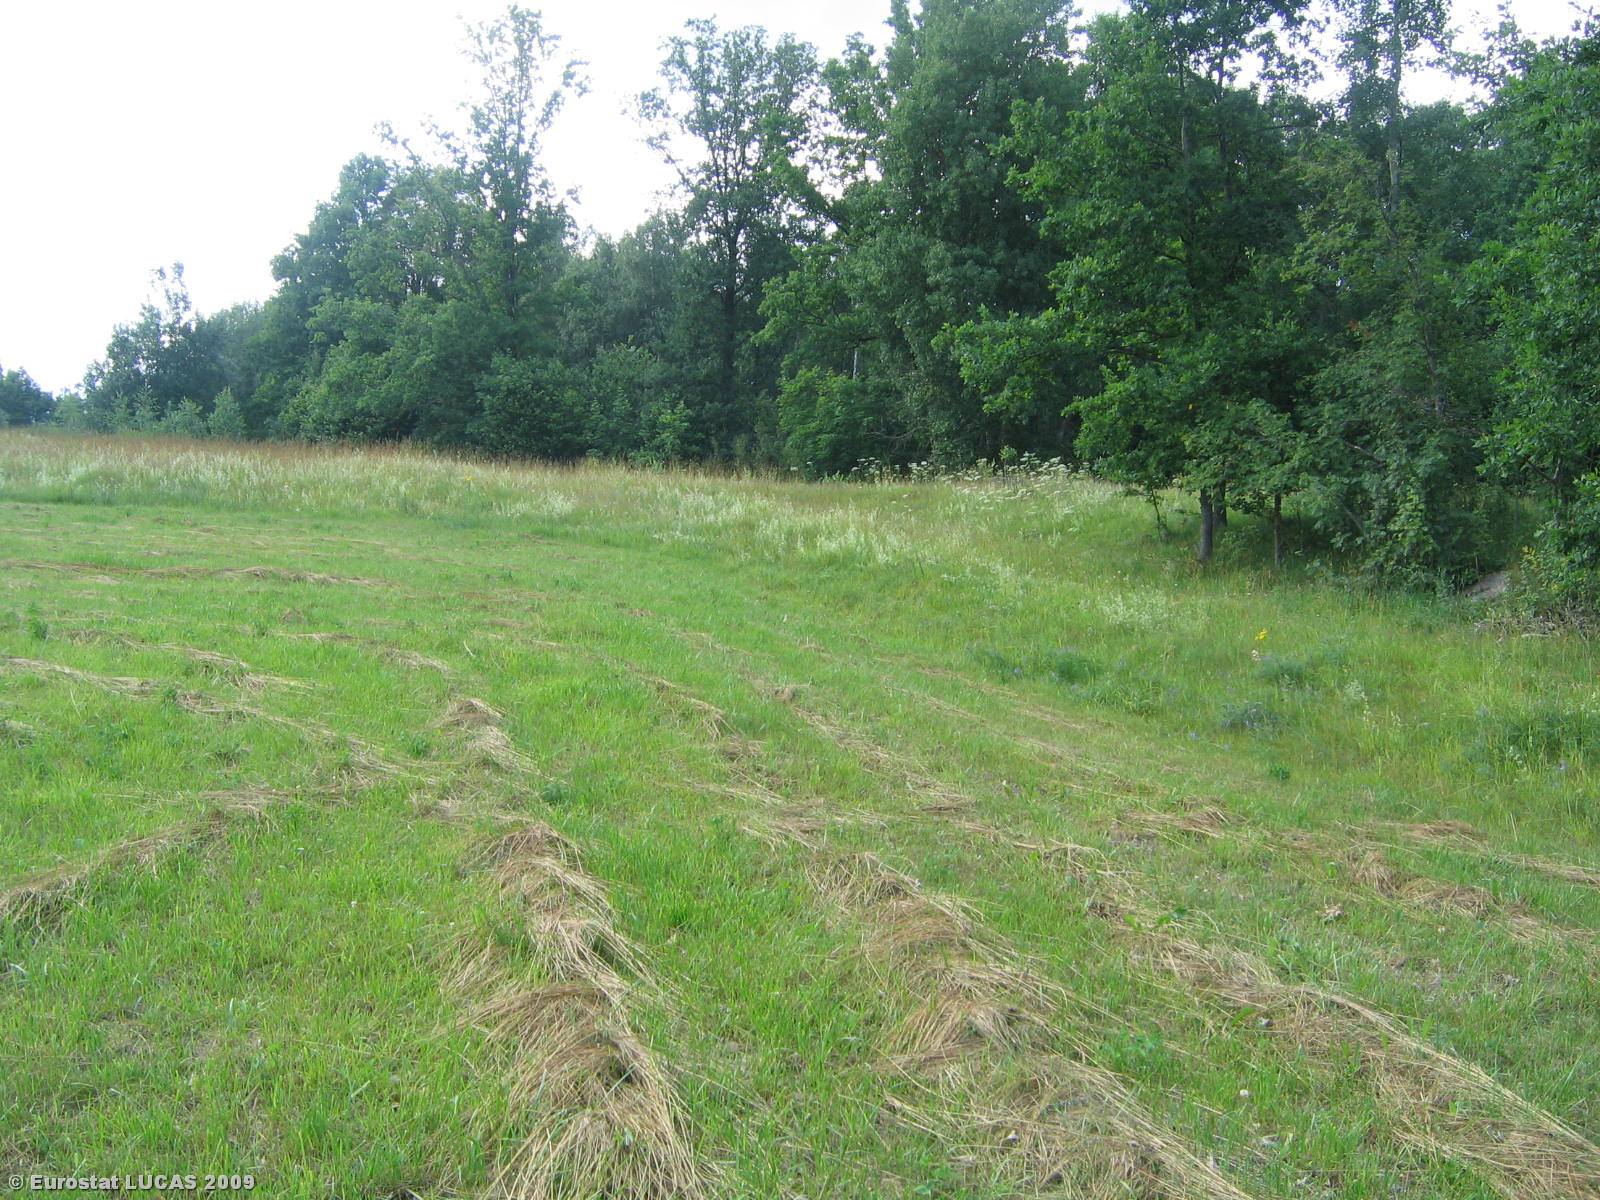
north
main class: Grassland
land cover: Grassland without tree/shrub cover
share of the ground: > 75 %
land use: Agriculture (excluding fallow land and kitchen gardens)
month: July
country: LT
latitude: 55.4093
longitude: 22.6841
